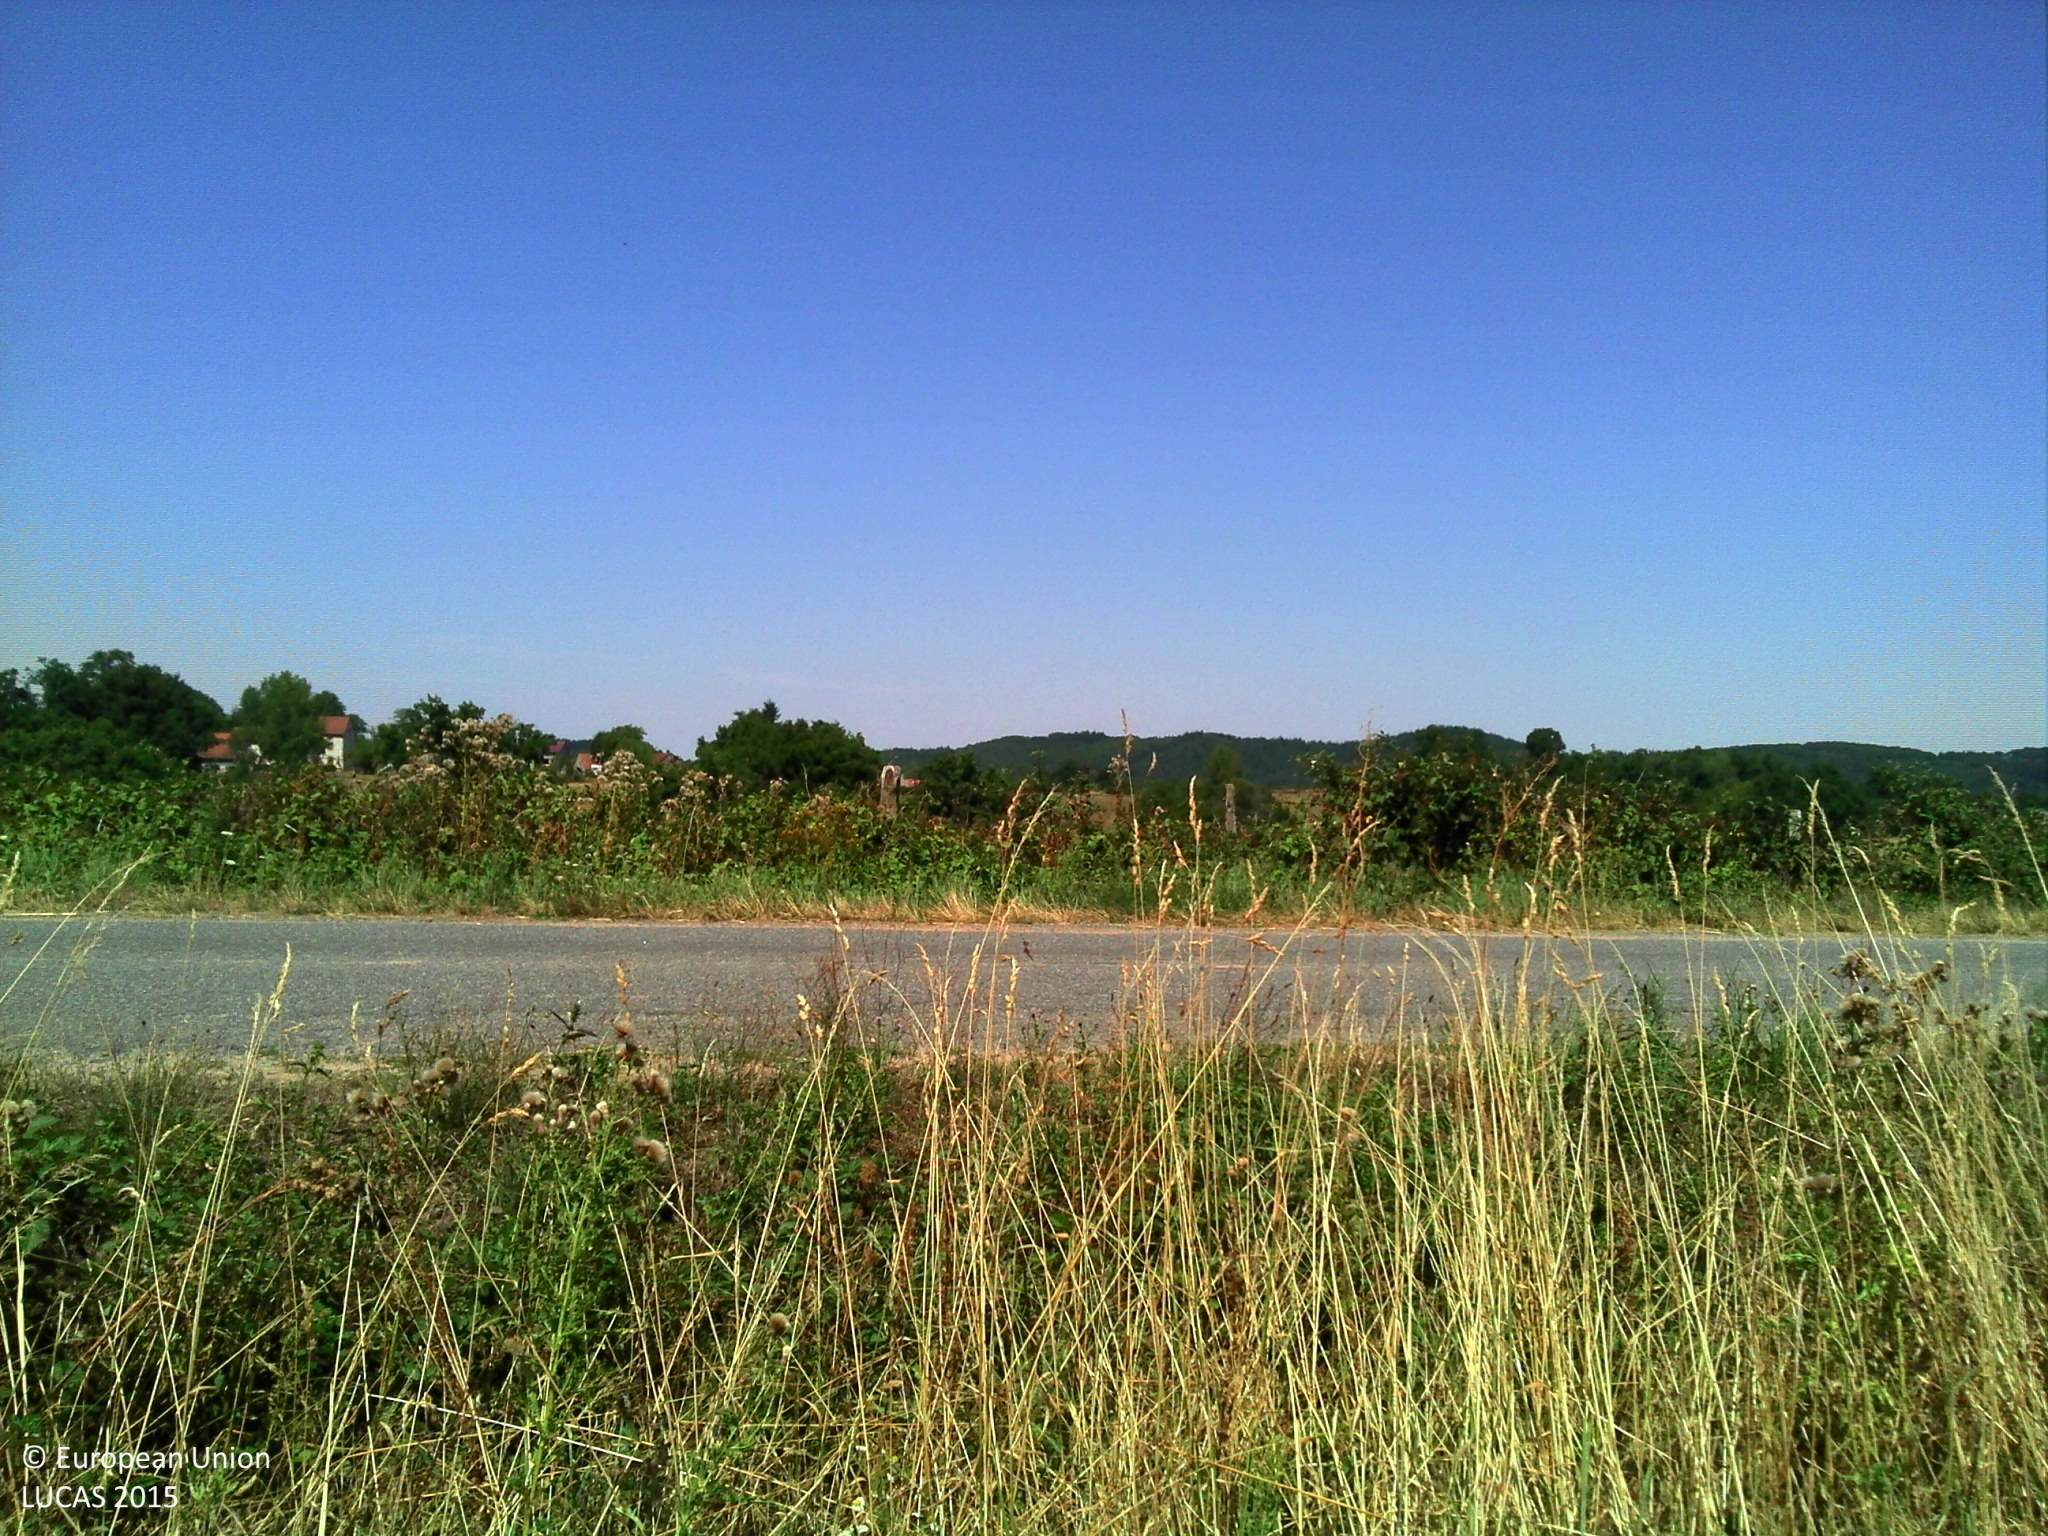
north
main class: Cropland
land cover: Triticale
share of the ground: 25 - 50 %
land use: Agriculture (excluding fallow land and kitchen gardens)
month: August
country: FR
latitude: 46.1082
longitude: 3.6480
